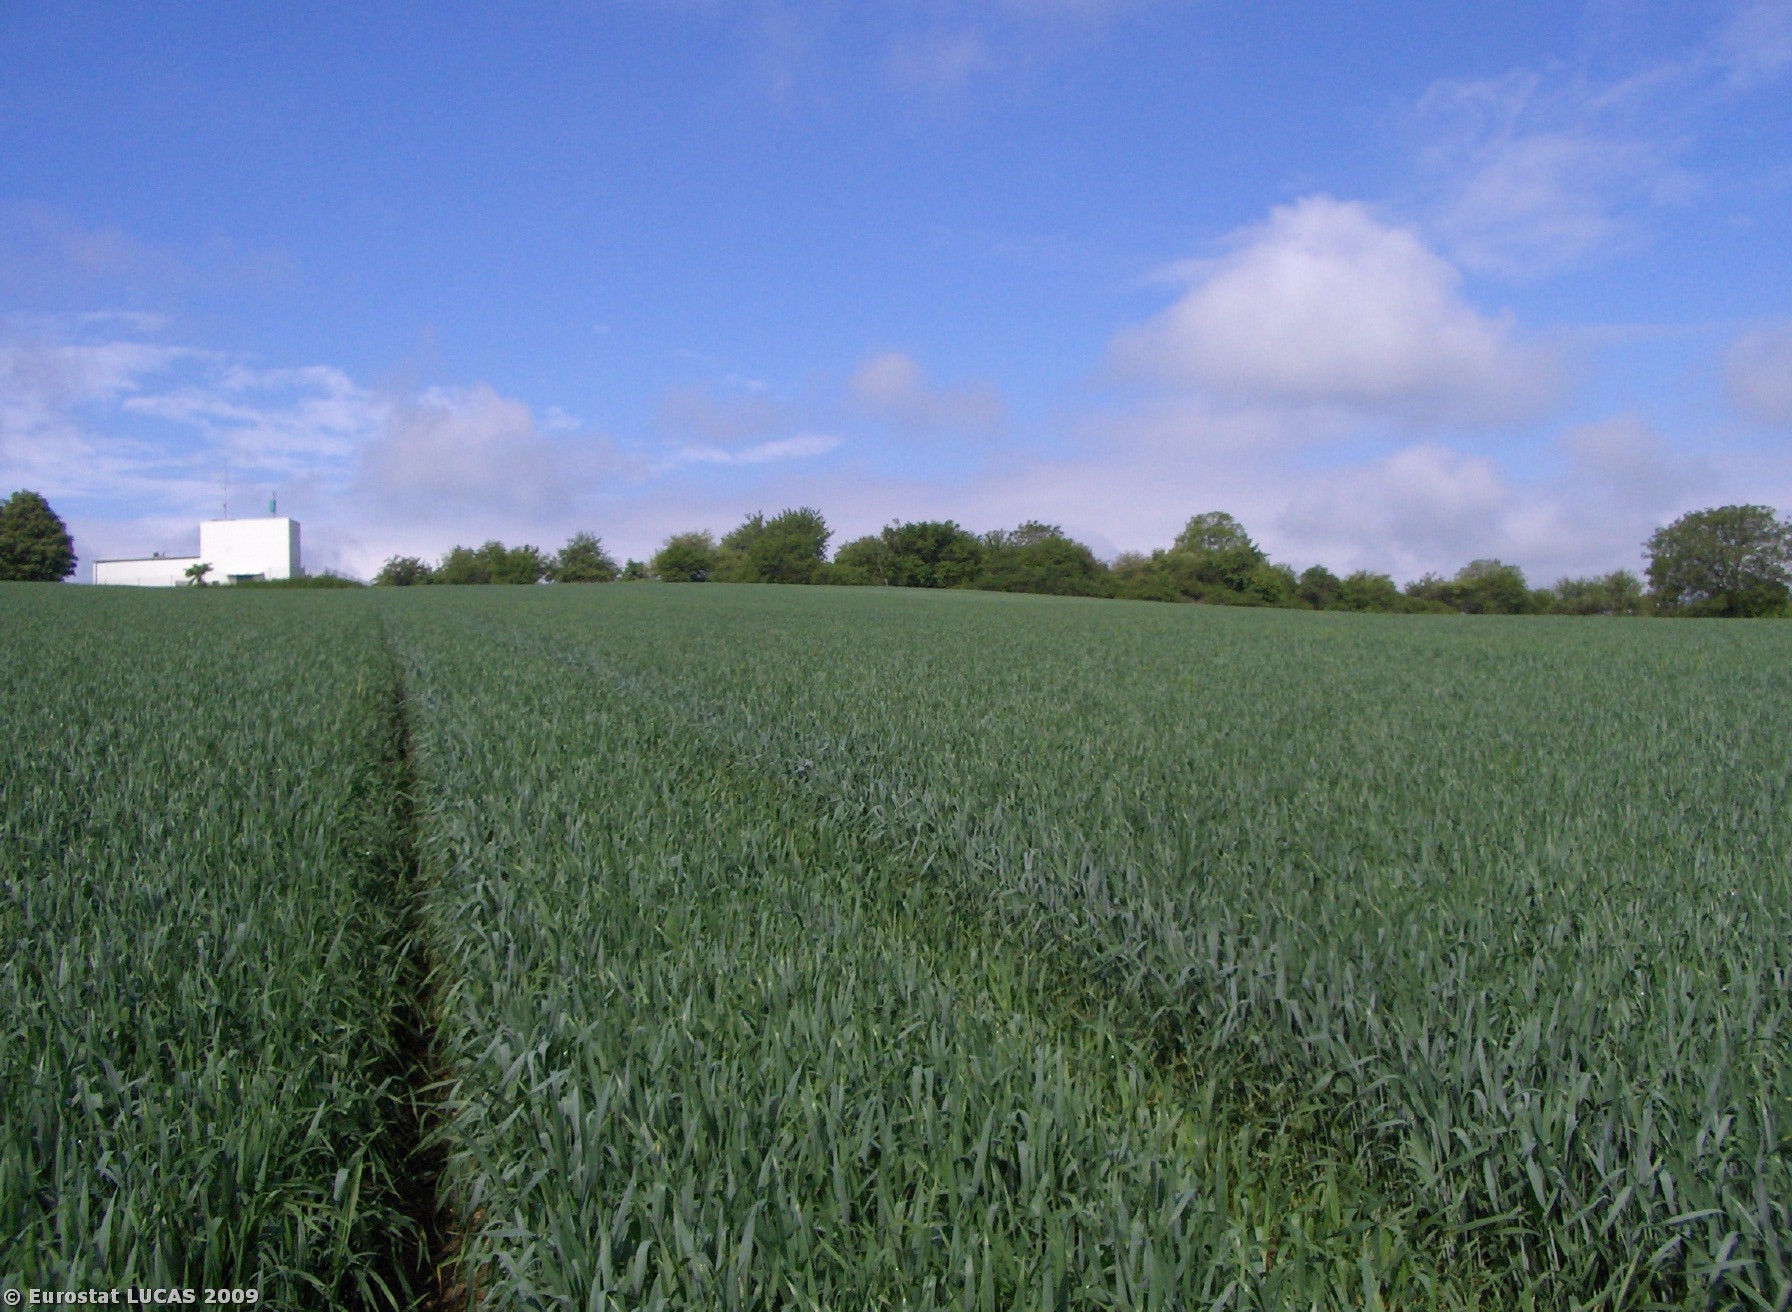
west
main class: Cropland
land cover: Common wheat
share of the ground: > 75 %
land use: Agriculture (excluding fallow land and kitchen gardens)
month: May
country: CZ
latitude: 49.4530
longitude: 14.3465
